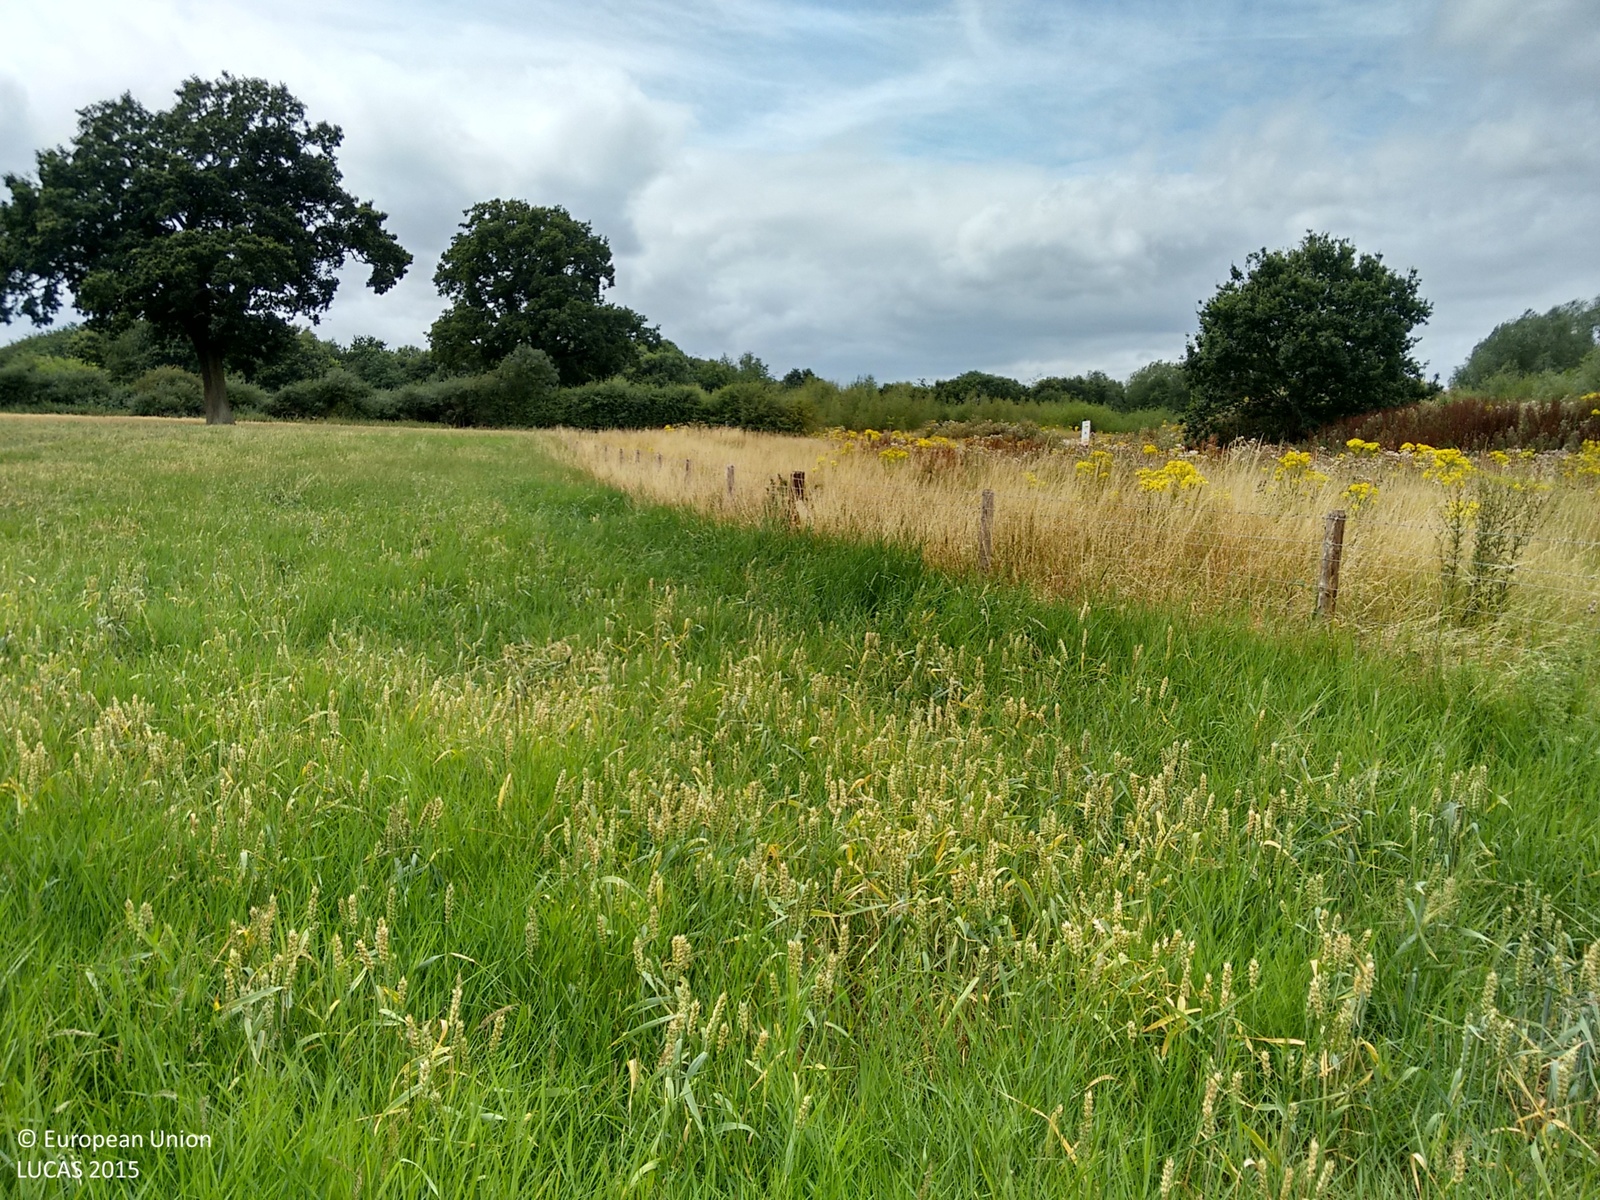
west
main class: Cropland
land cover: Mixed cereals for fodder
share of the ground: 50 - 75 %
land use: Agriculture (excluding fallow land and kitchen gardens)
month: August
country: GB
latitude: 51.2539
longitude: -0.1357
